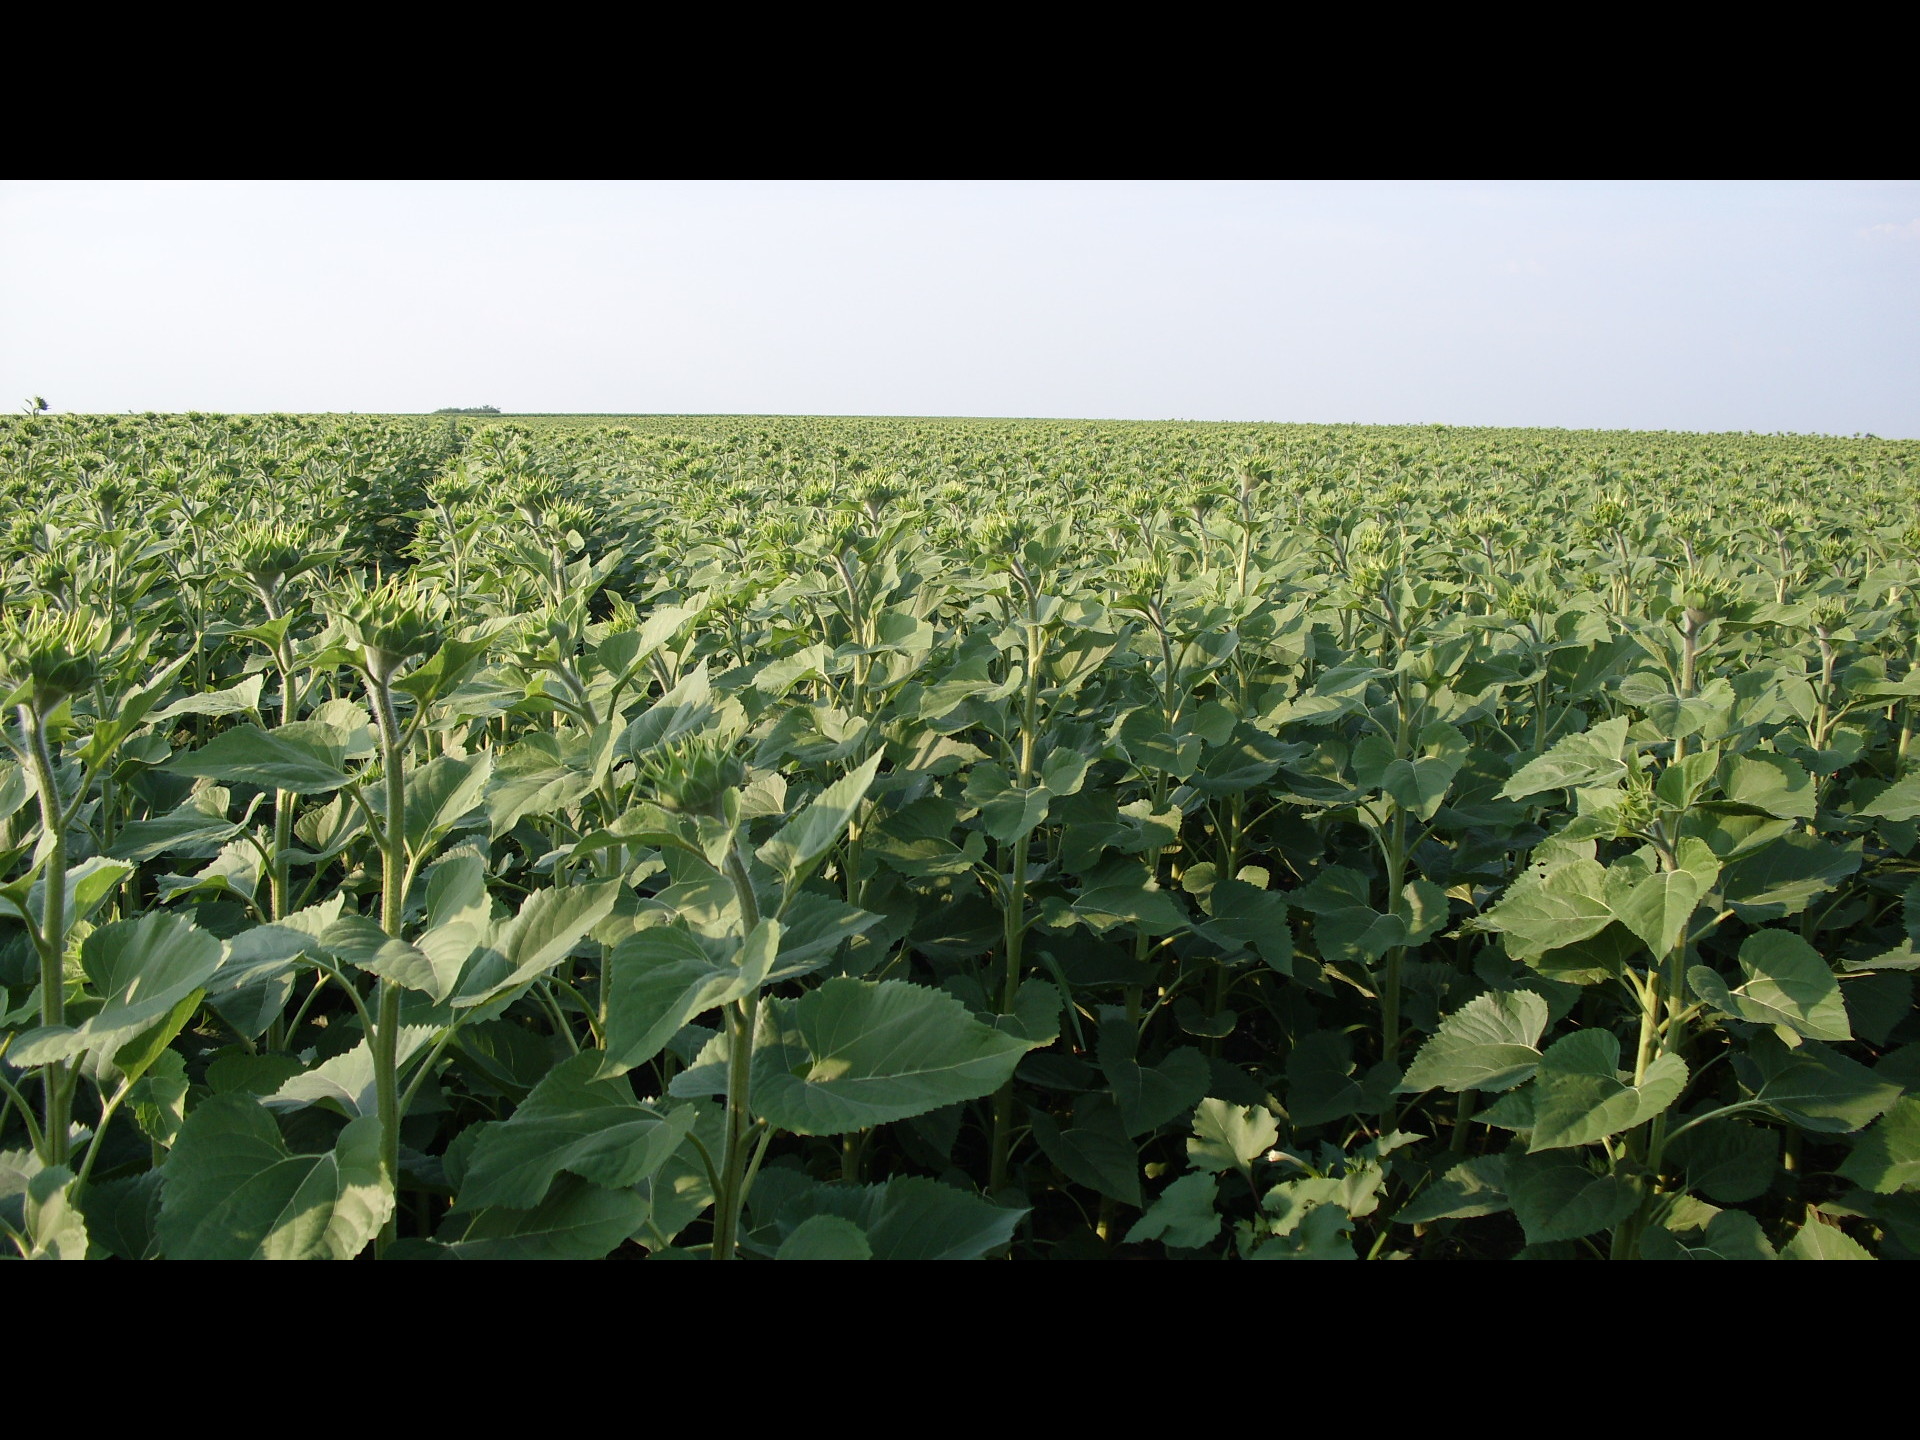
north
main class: Cropland
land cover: Sunflower
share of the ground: > 75 %
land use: Agriculture (excluding fallow land and kitchen gardens)
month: June
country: BG
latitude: 43.6902
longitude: 23.5832
